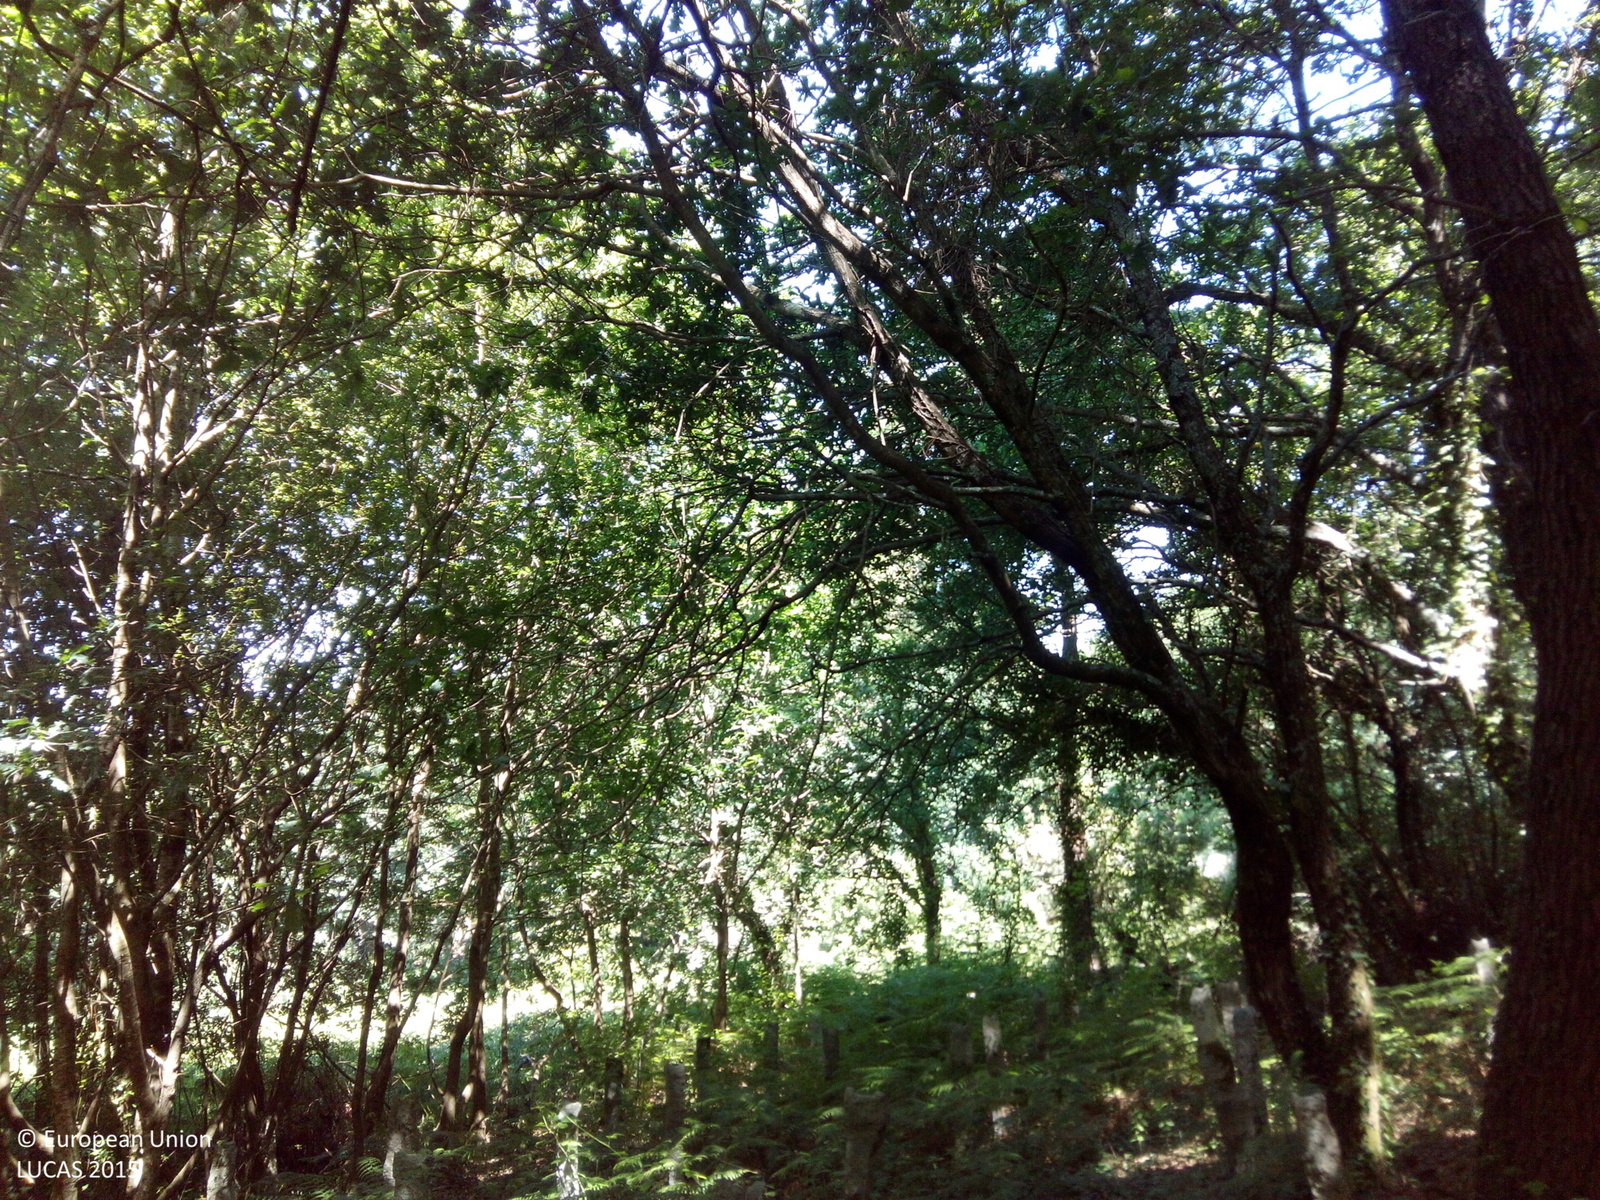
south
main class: Woodland
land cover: Broadleaved woodland
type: thermophilous deciduous forest
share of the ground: > 75 %
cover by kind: broadleaved forest trees 100 %
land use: Forestry
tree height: > 5 m
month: May
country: ES
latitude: 42.0767
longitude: -8.8005
